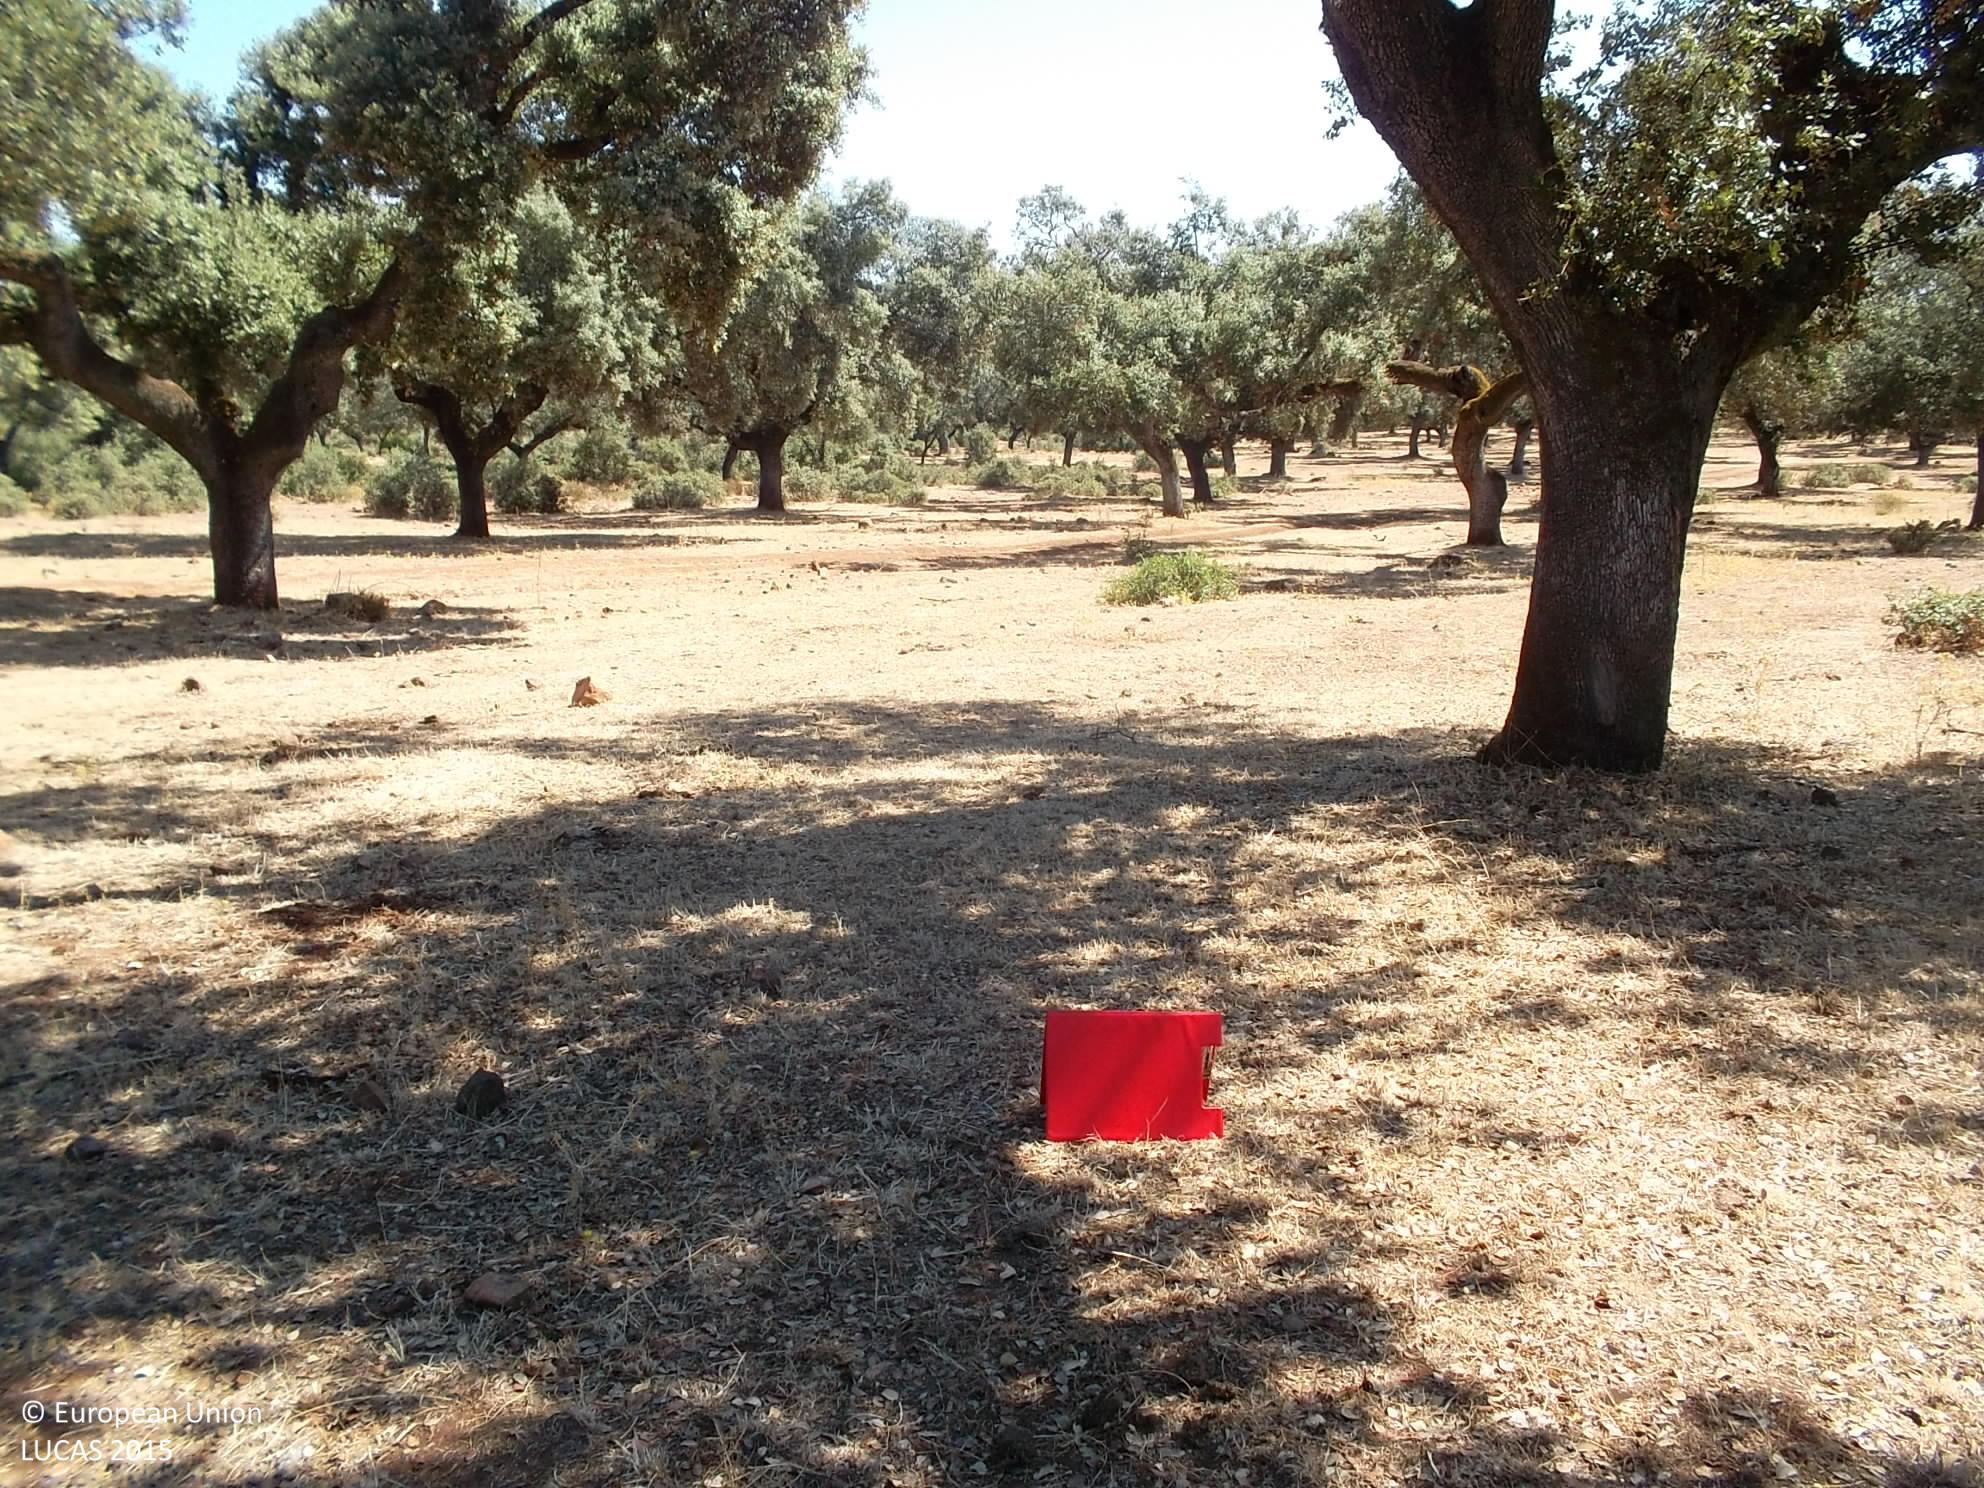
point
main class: Woodland
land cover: Broadleaved woodland
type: broadleaved evergreen forest
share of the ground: 50 - 75 %
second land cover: Grassland without tree/shrub cover
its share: 50 - 75 %
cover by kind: broadleaved forest trees 50 %, herbaceous plants 50 %
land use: Forestry
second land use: Agriculture (excluding fallow land and kitchen gardens)
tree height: > 5 m
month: August
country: ES
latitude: 38.2388
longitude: -6.6756
